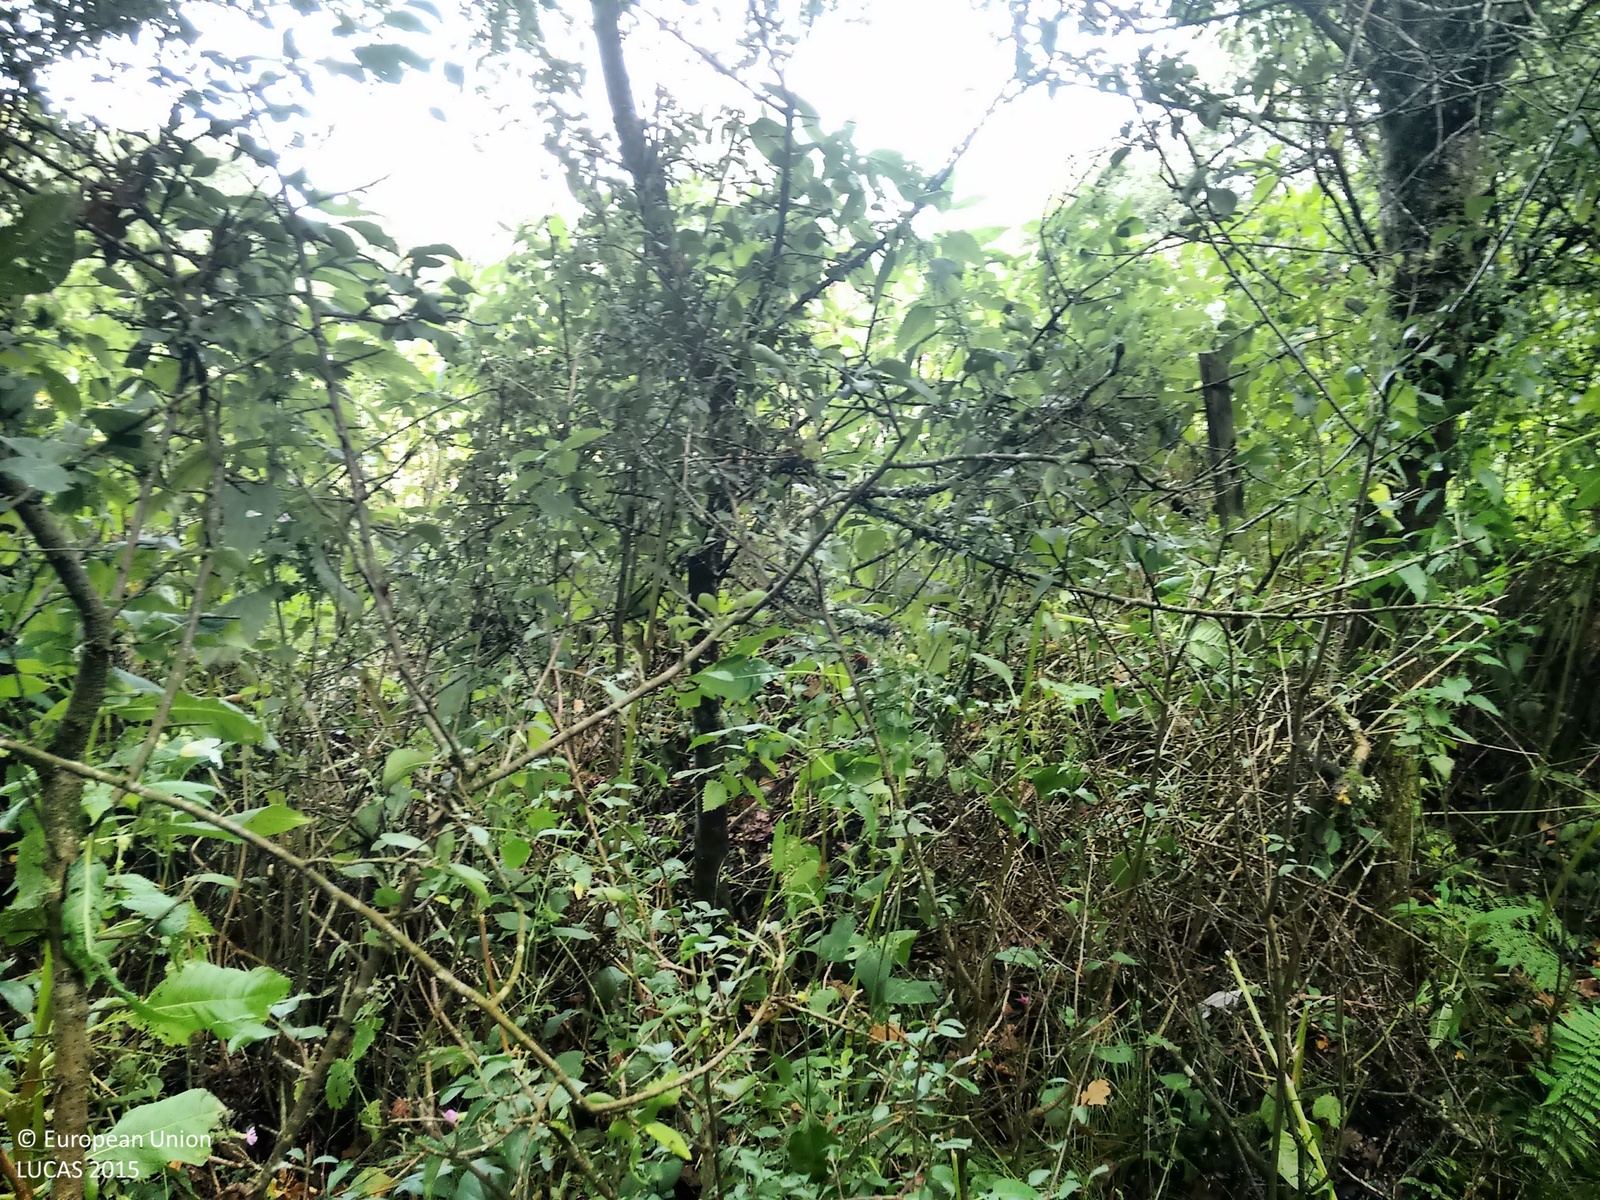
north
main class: Woodland
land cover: Broadleaved woodland
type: mesophytic deciduous forest
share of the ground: > 75 %
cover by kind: broadleaved forest trees 100 %
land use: Semi-natural and natural areas not in use
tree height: > 5 m
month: September
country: GB
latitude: 50.7613
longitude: -4.4072
